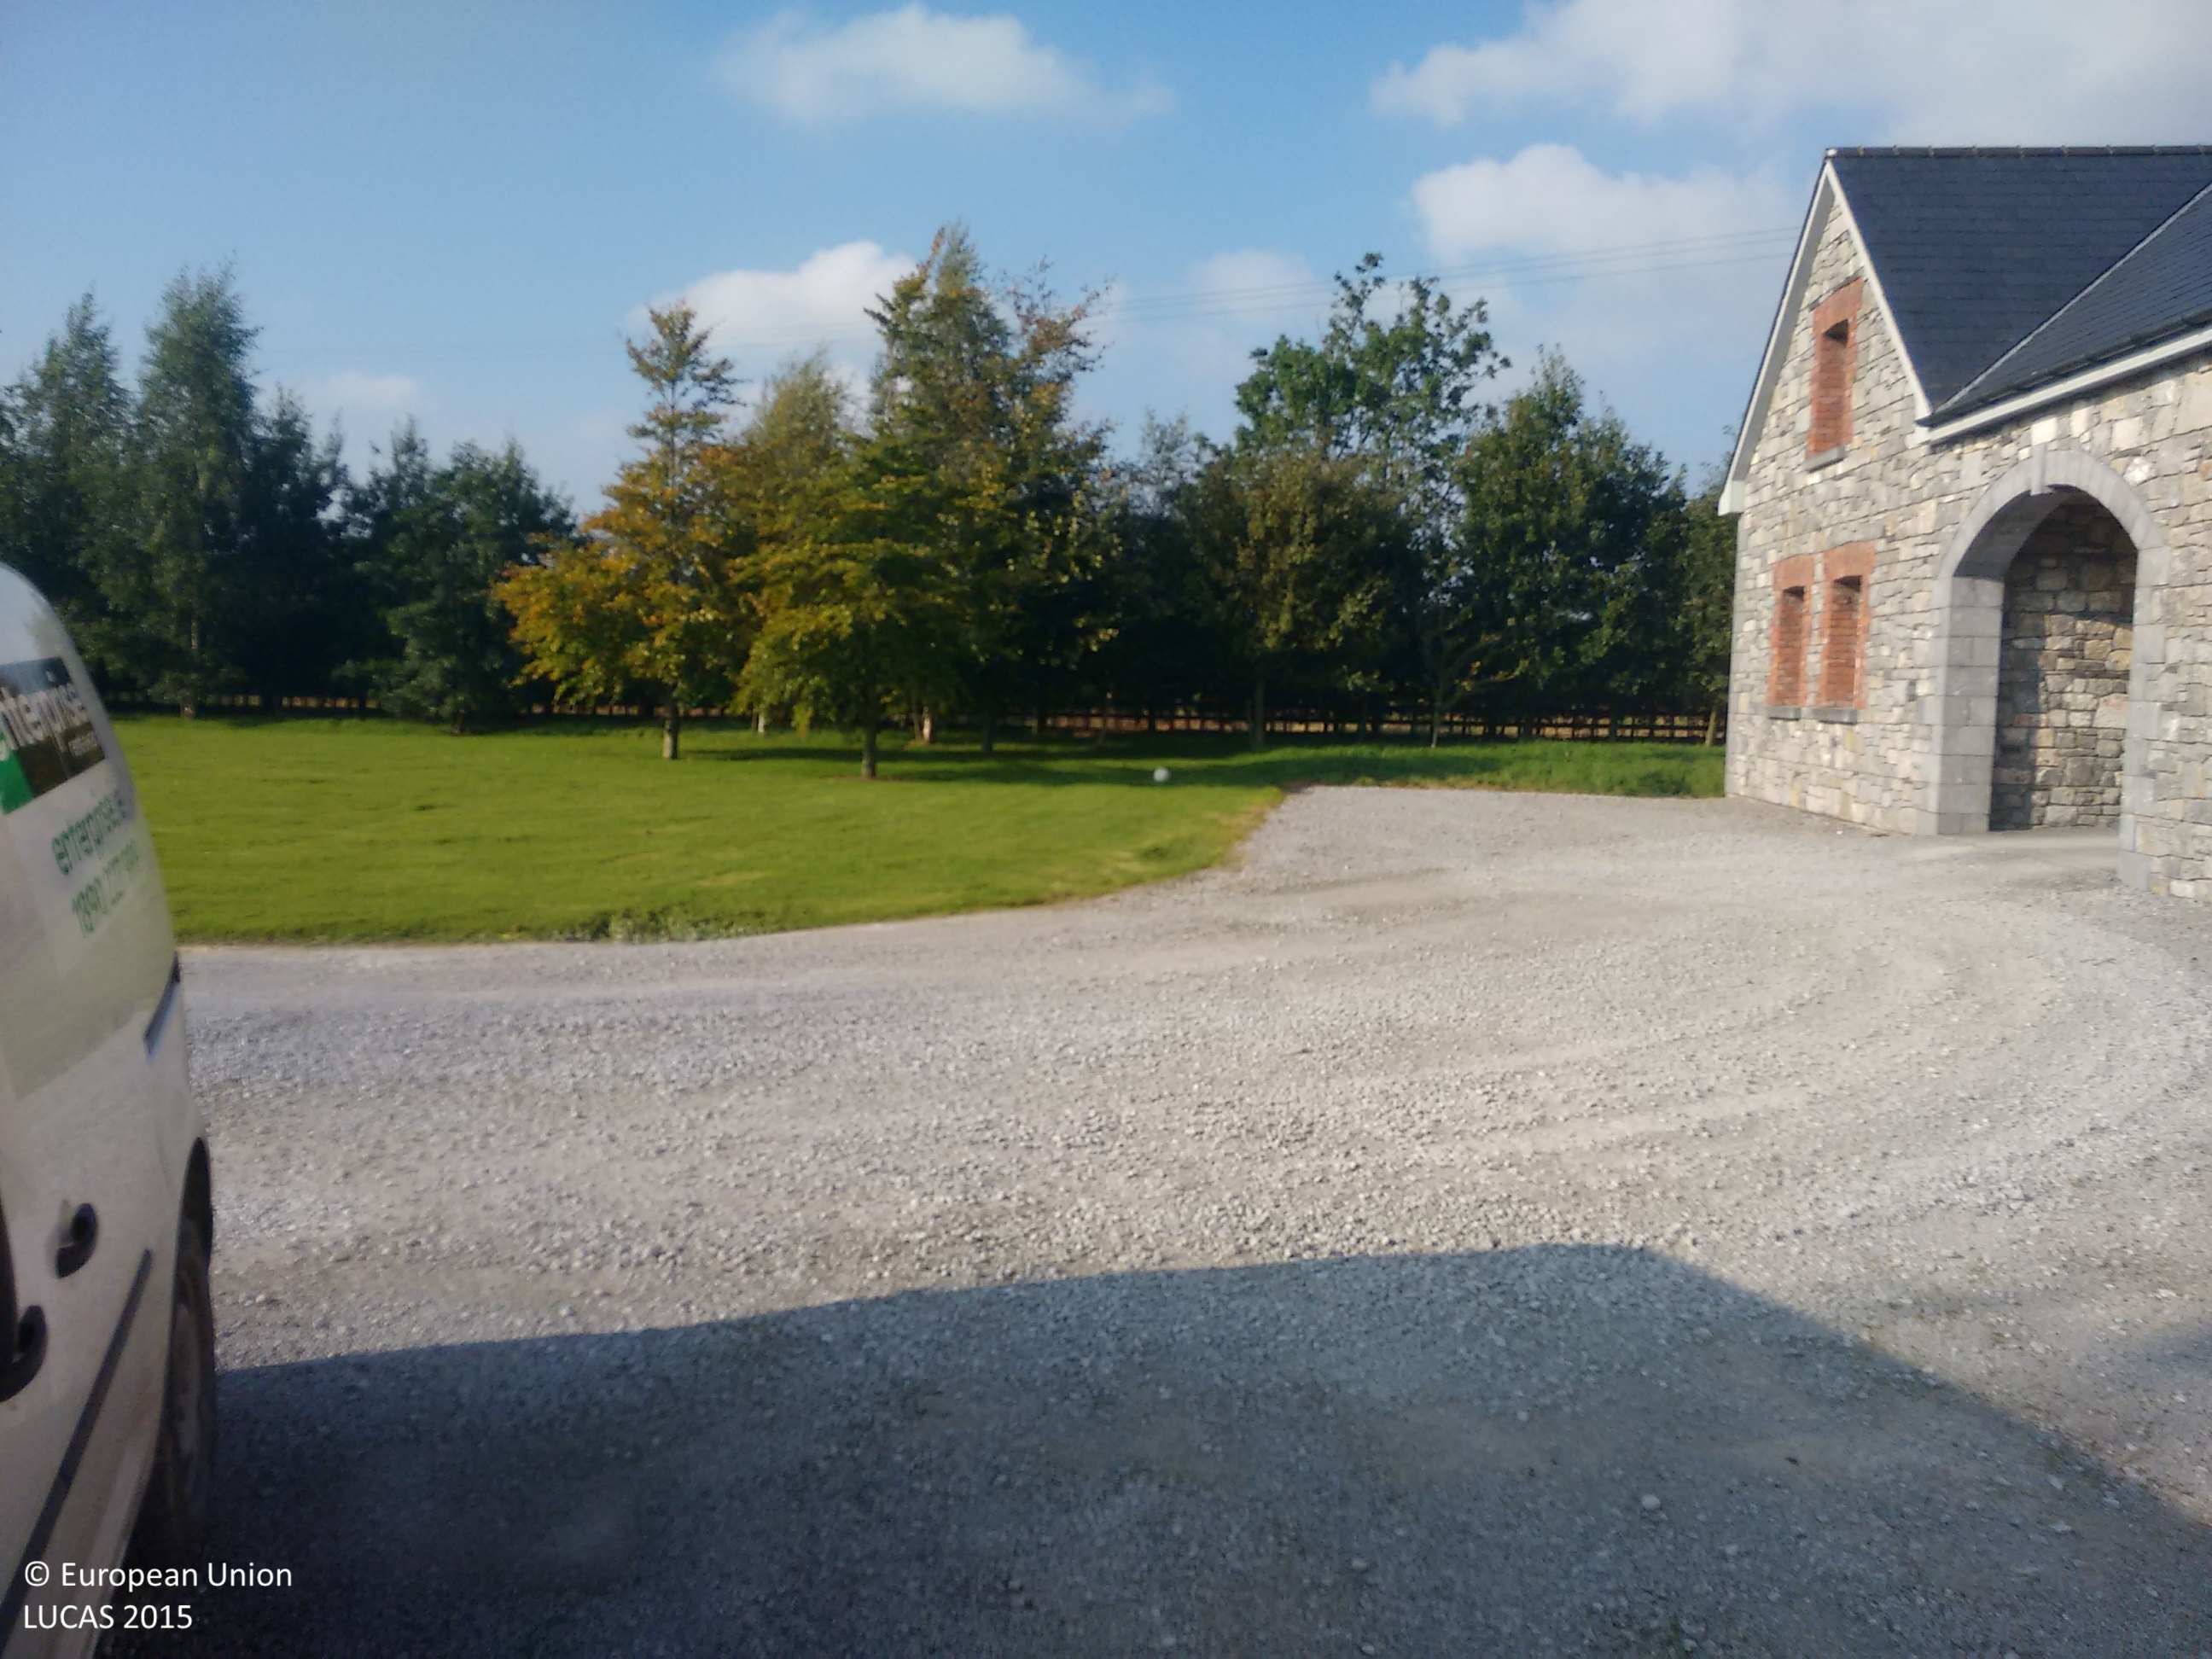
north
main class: Grassland
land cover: Grassland without tree/shrub cover
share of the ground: > 75 %
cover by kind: herbaceous plants 100 %
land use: Residential
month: October
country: IE
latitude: 52.4355
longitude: -9.0885
